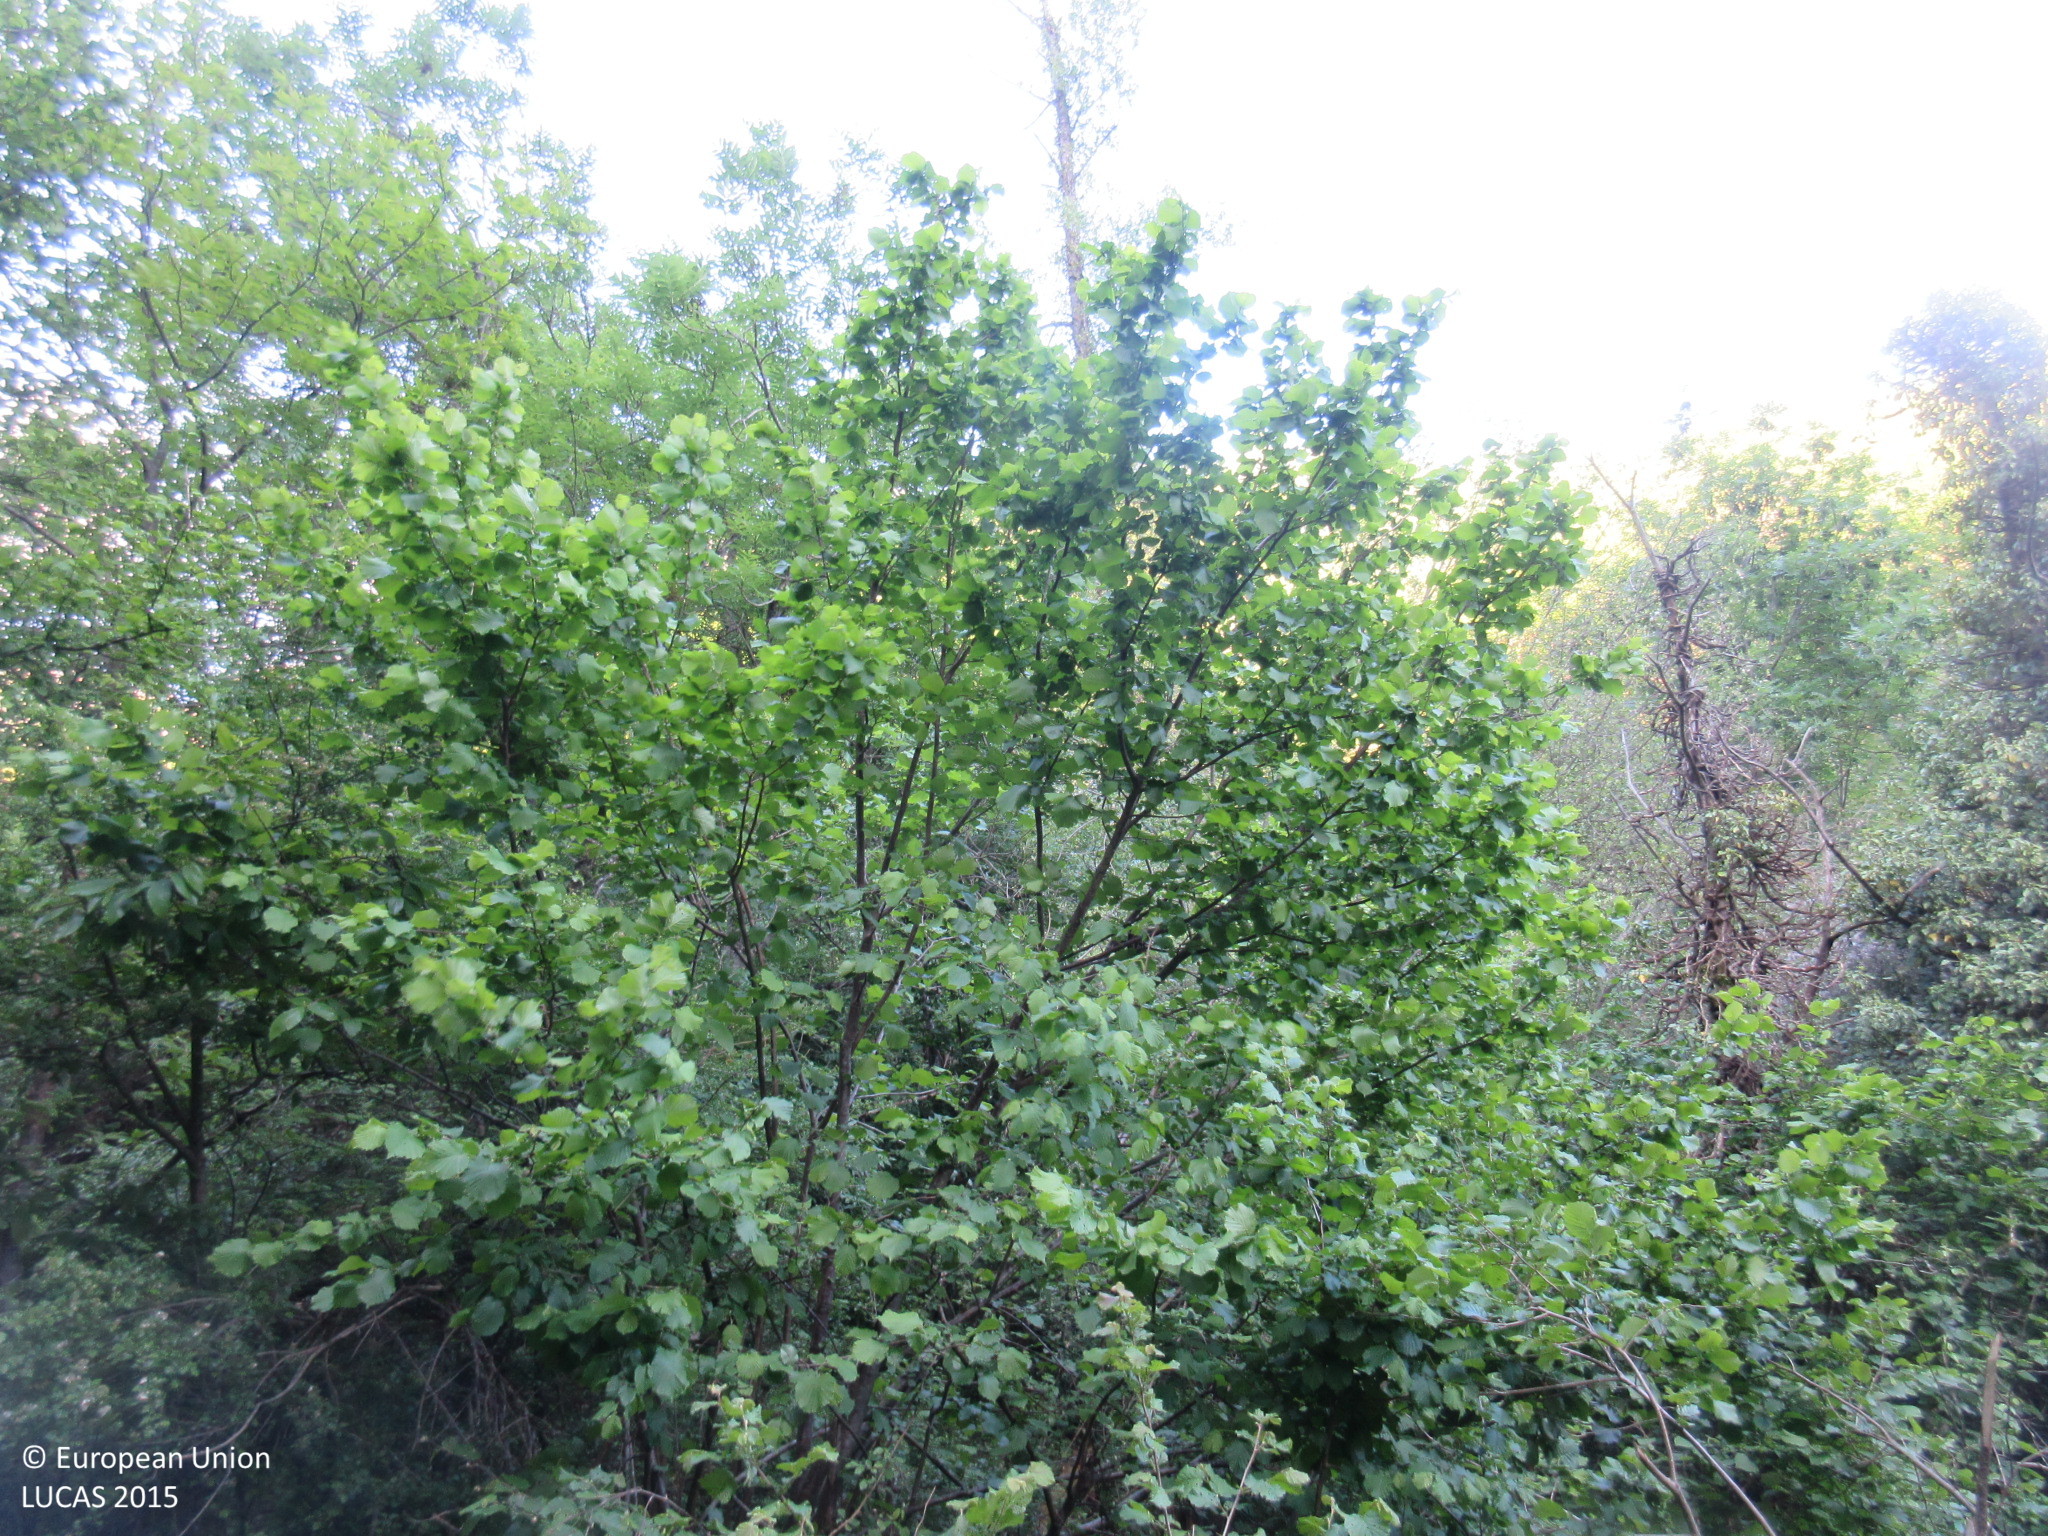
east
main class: Woodland
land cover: Broadleaved woodland
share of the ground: > 75 %
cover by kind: broadleaved forest trees 95 %, shrubs 5 %
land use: Semi-natural and natural areas not in use
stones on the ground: 25 - 50 %
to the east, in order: Broadleaved woodland; Tracks; Broadleaved woodland; Inland fresh running water; Fences; Grassland with sparse tree/shrub cover; Groves; Fences; Shrubland without tree cover; Fences; Broadleaved woodland
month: May
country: ES
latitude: 43.1183
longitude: -5.5268
